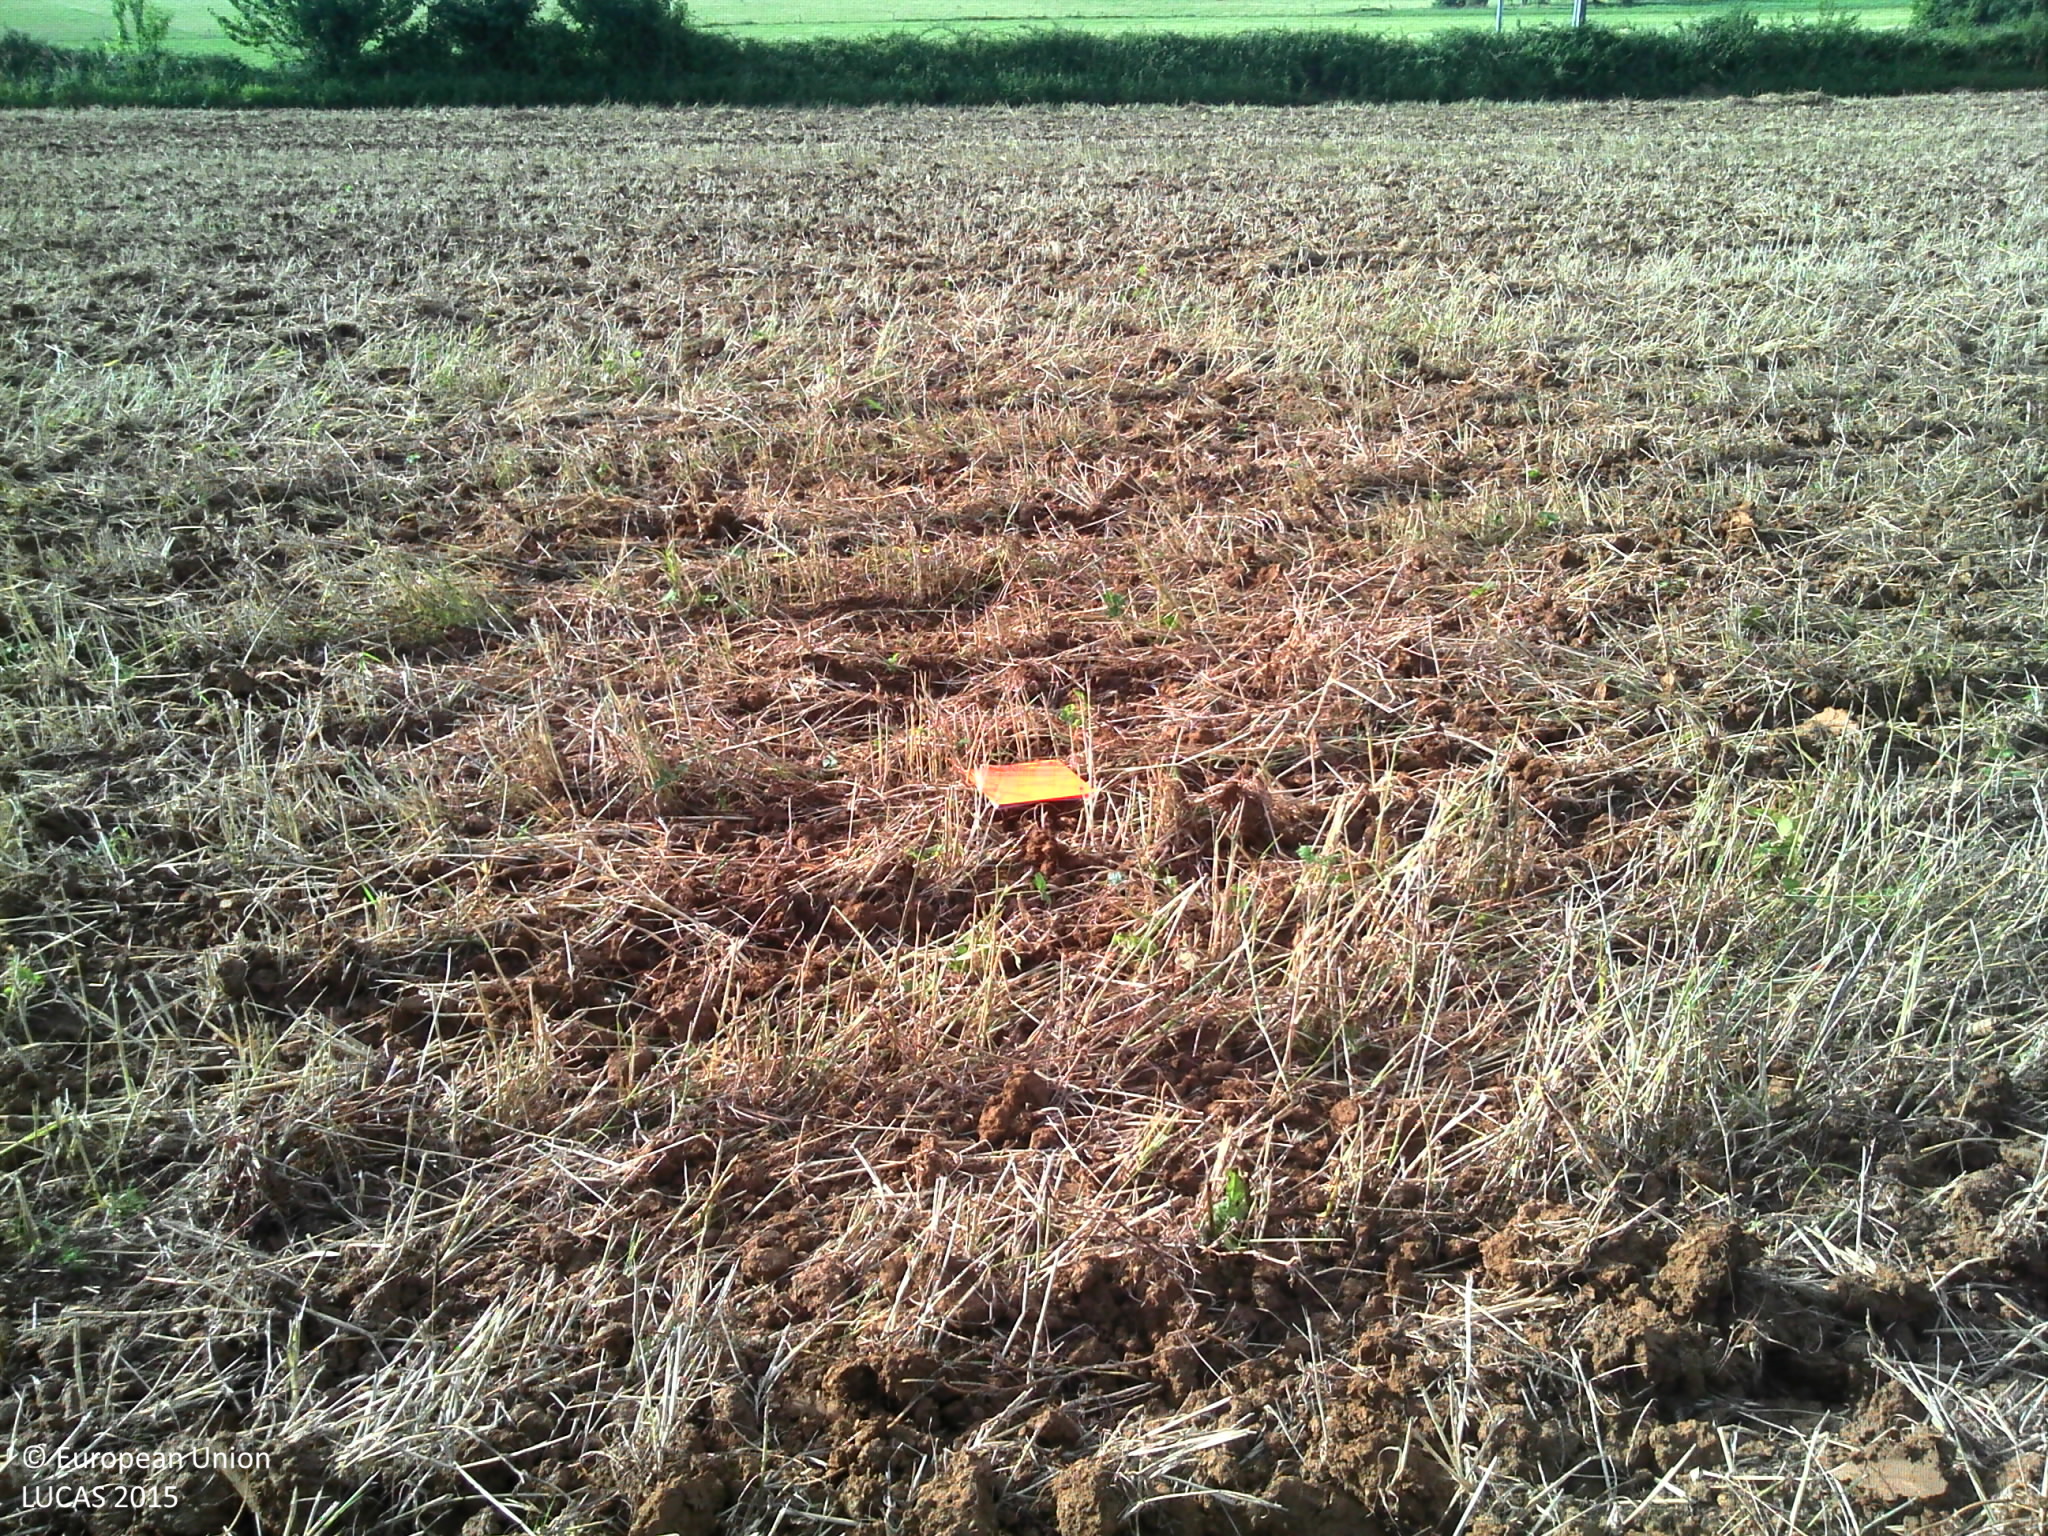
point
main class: Cropland
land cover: Barley
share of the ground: < 10 %
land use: Agriculture (excluding fallow land and kitchen gardens)
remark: Harvested field
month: June
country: FR
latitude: 46.6845
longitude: 0.4501
